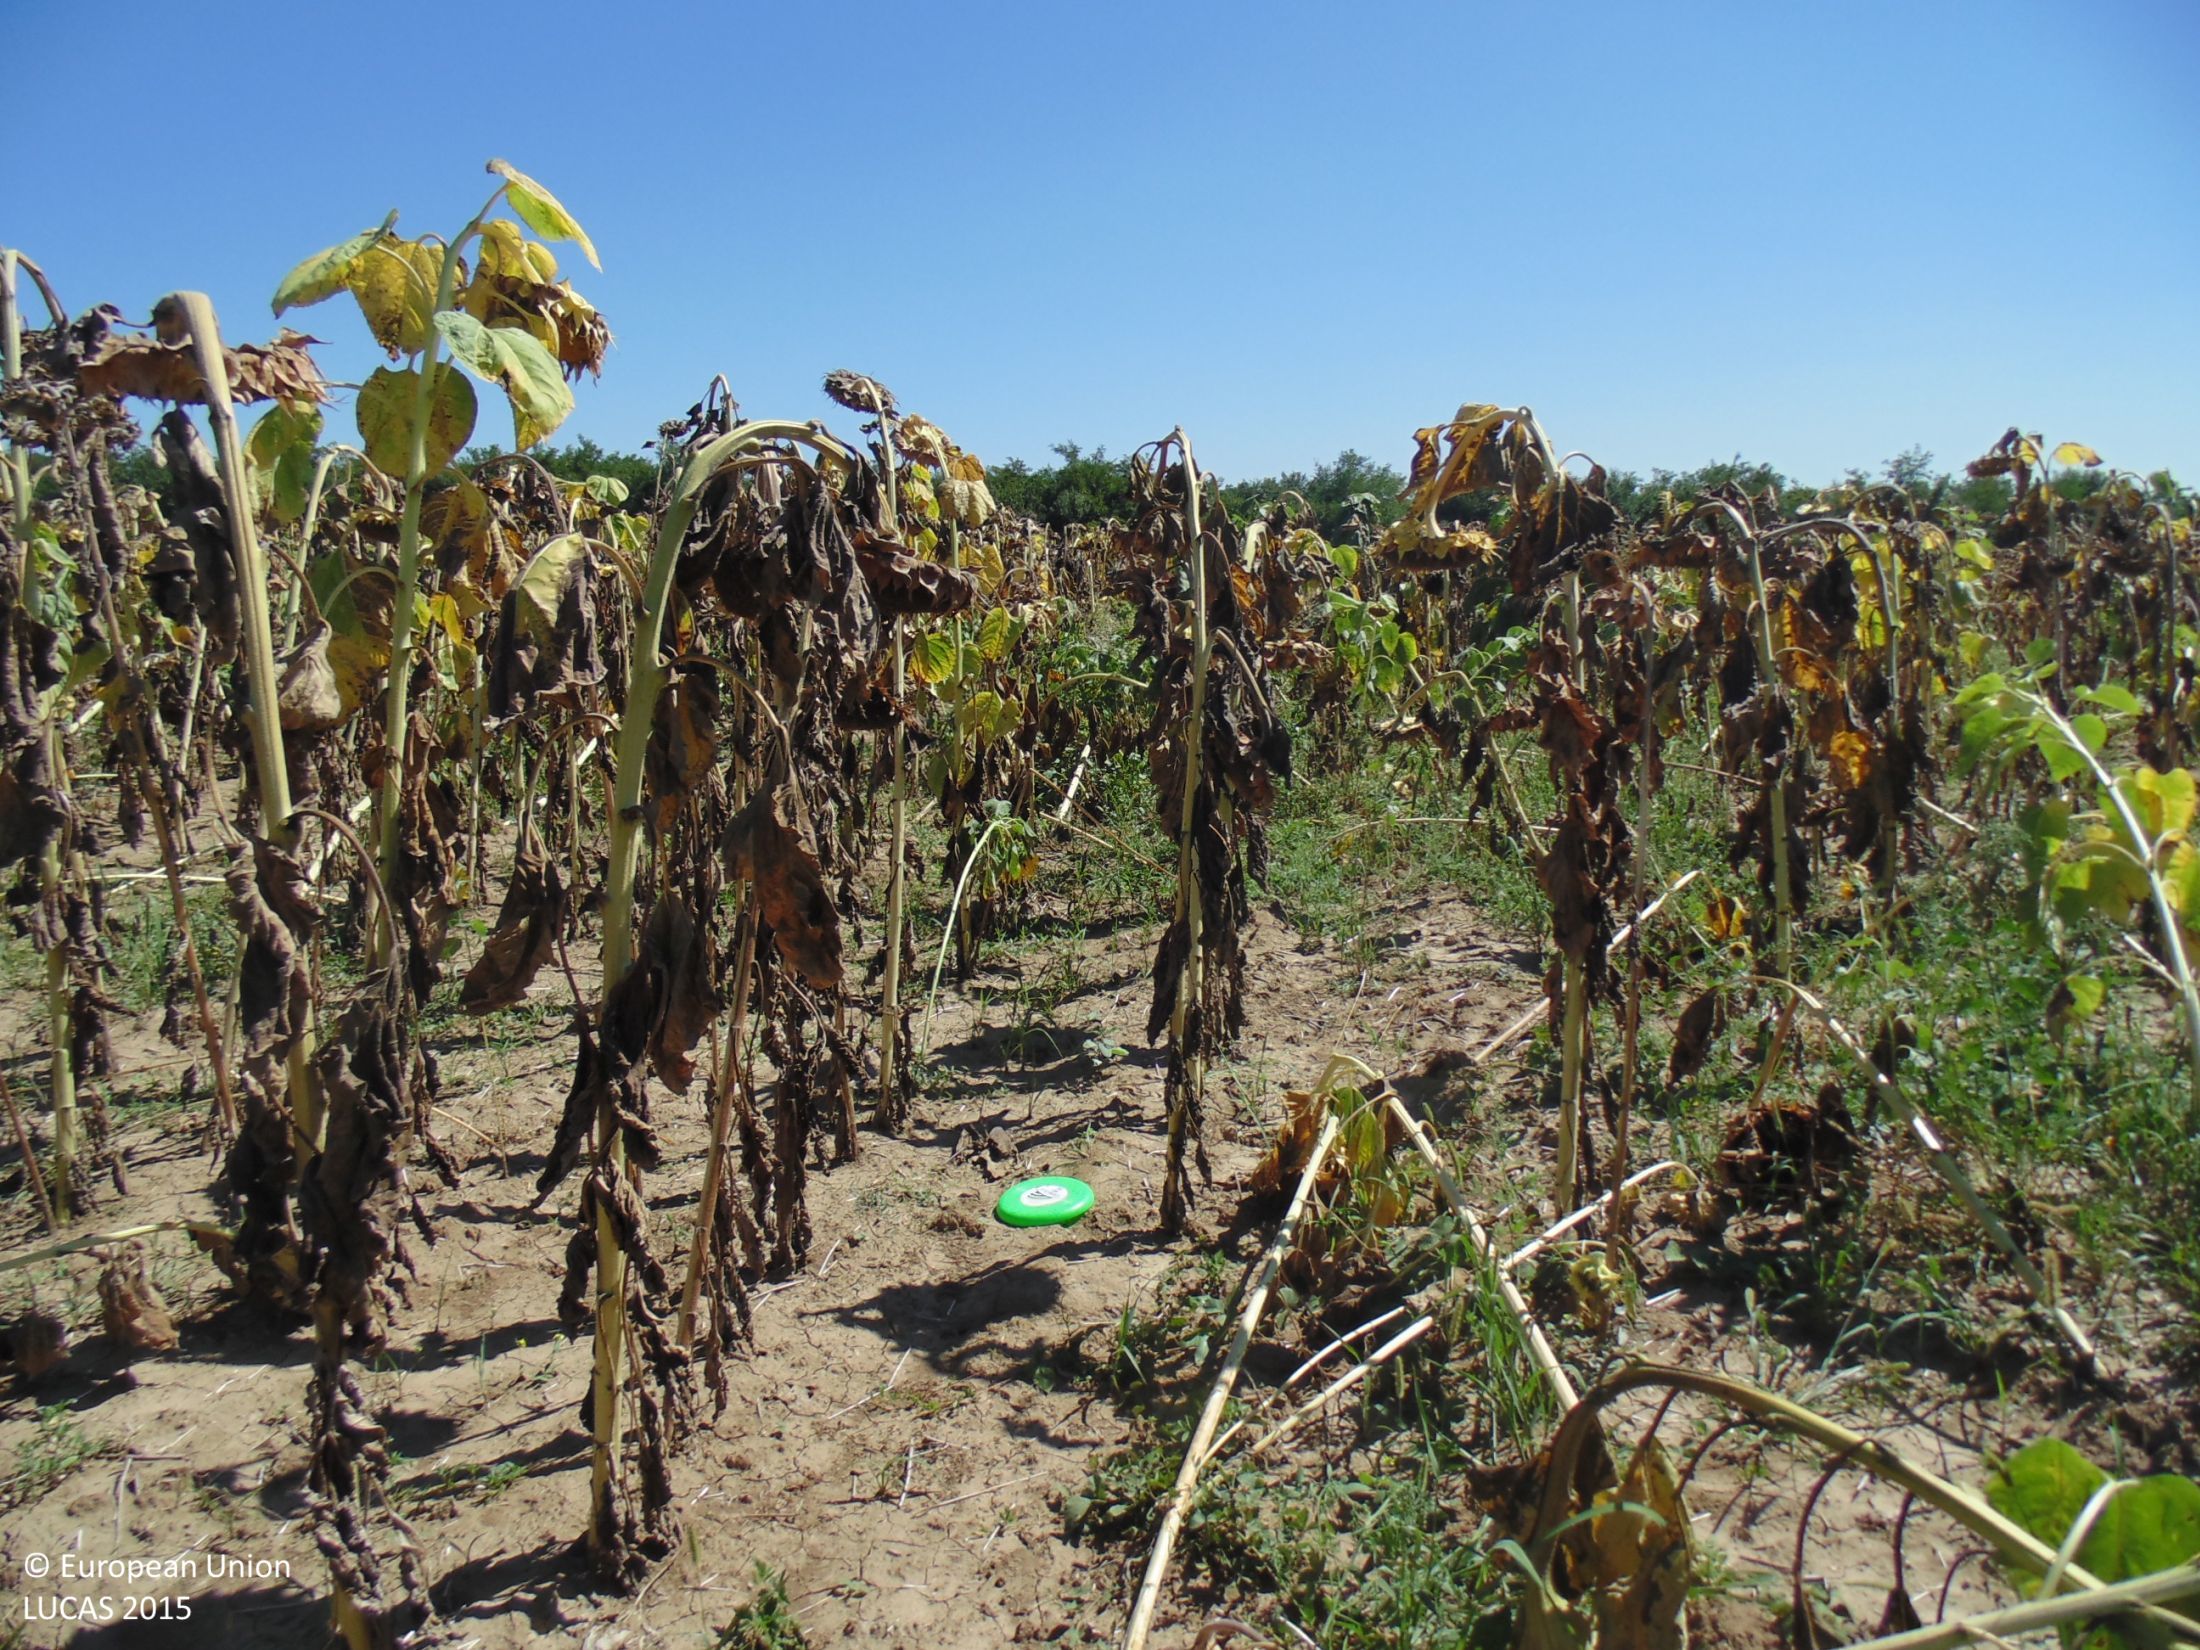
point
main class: Cropland
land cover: Sunflower
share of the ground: > 75 %
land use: Agriculture (excluding fallow land and kitchen gardens)
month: September
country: BG
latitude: 43.7643
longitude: 27.1039
